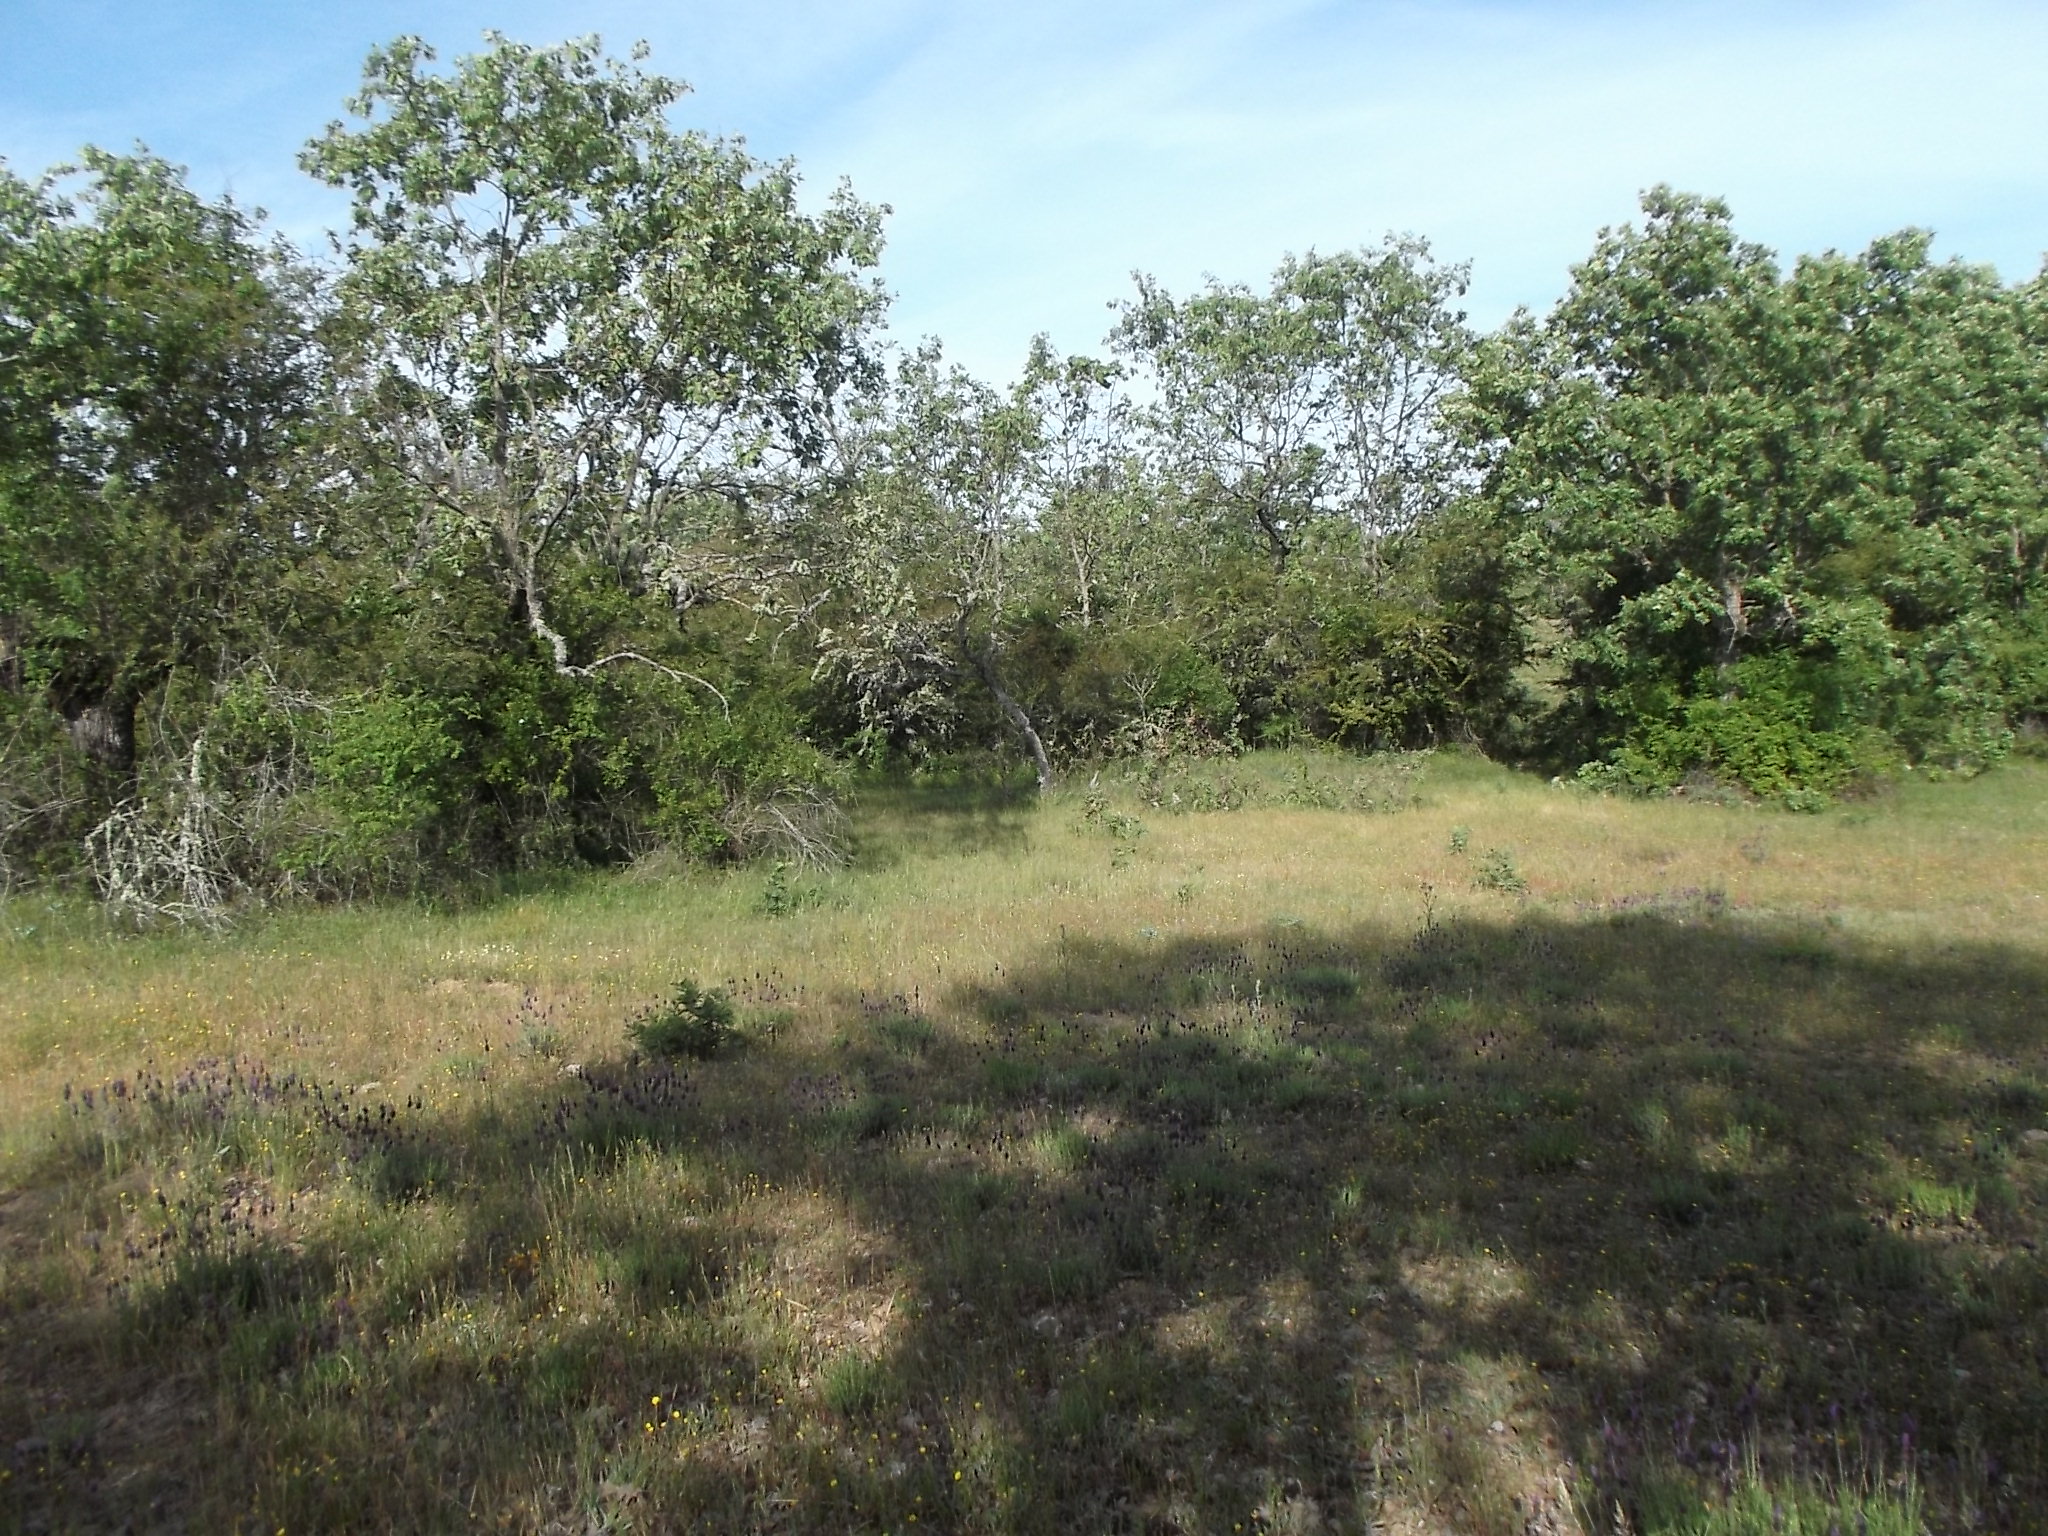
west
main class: Grassland
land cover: Grassland with sparse tree/shrub cover
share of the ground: > 75 %
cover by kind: herbaceous plants 90 %, broadleaved forest trees 5 %, shrubs 5 %
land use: Agriculture (excluding fallow land and kitchen gardens)
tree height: > 5 m
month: May
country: ES
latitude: 40.9894
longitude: -6.3163
